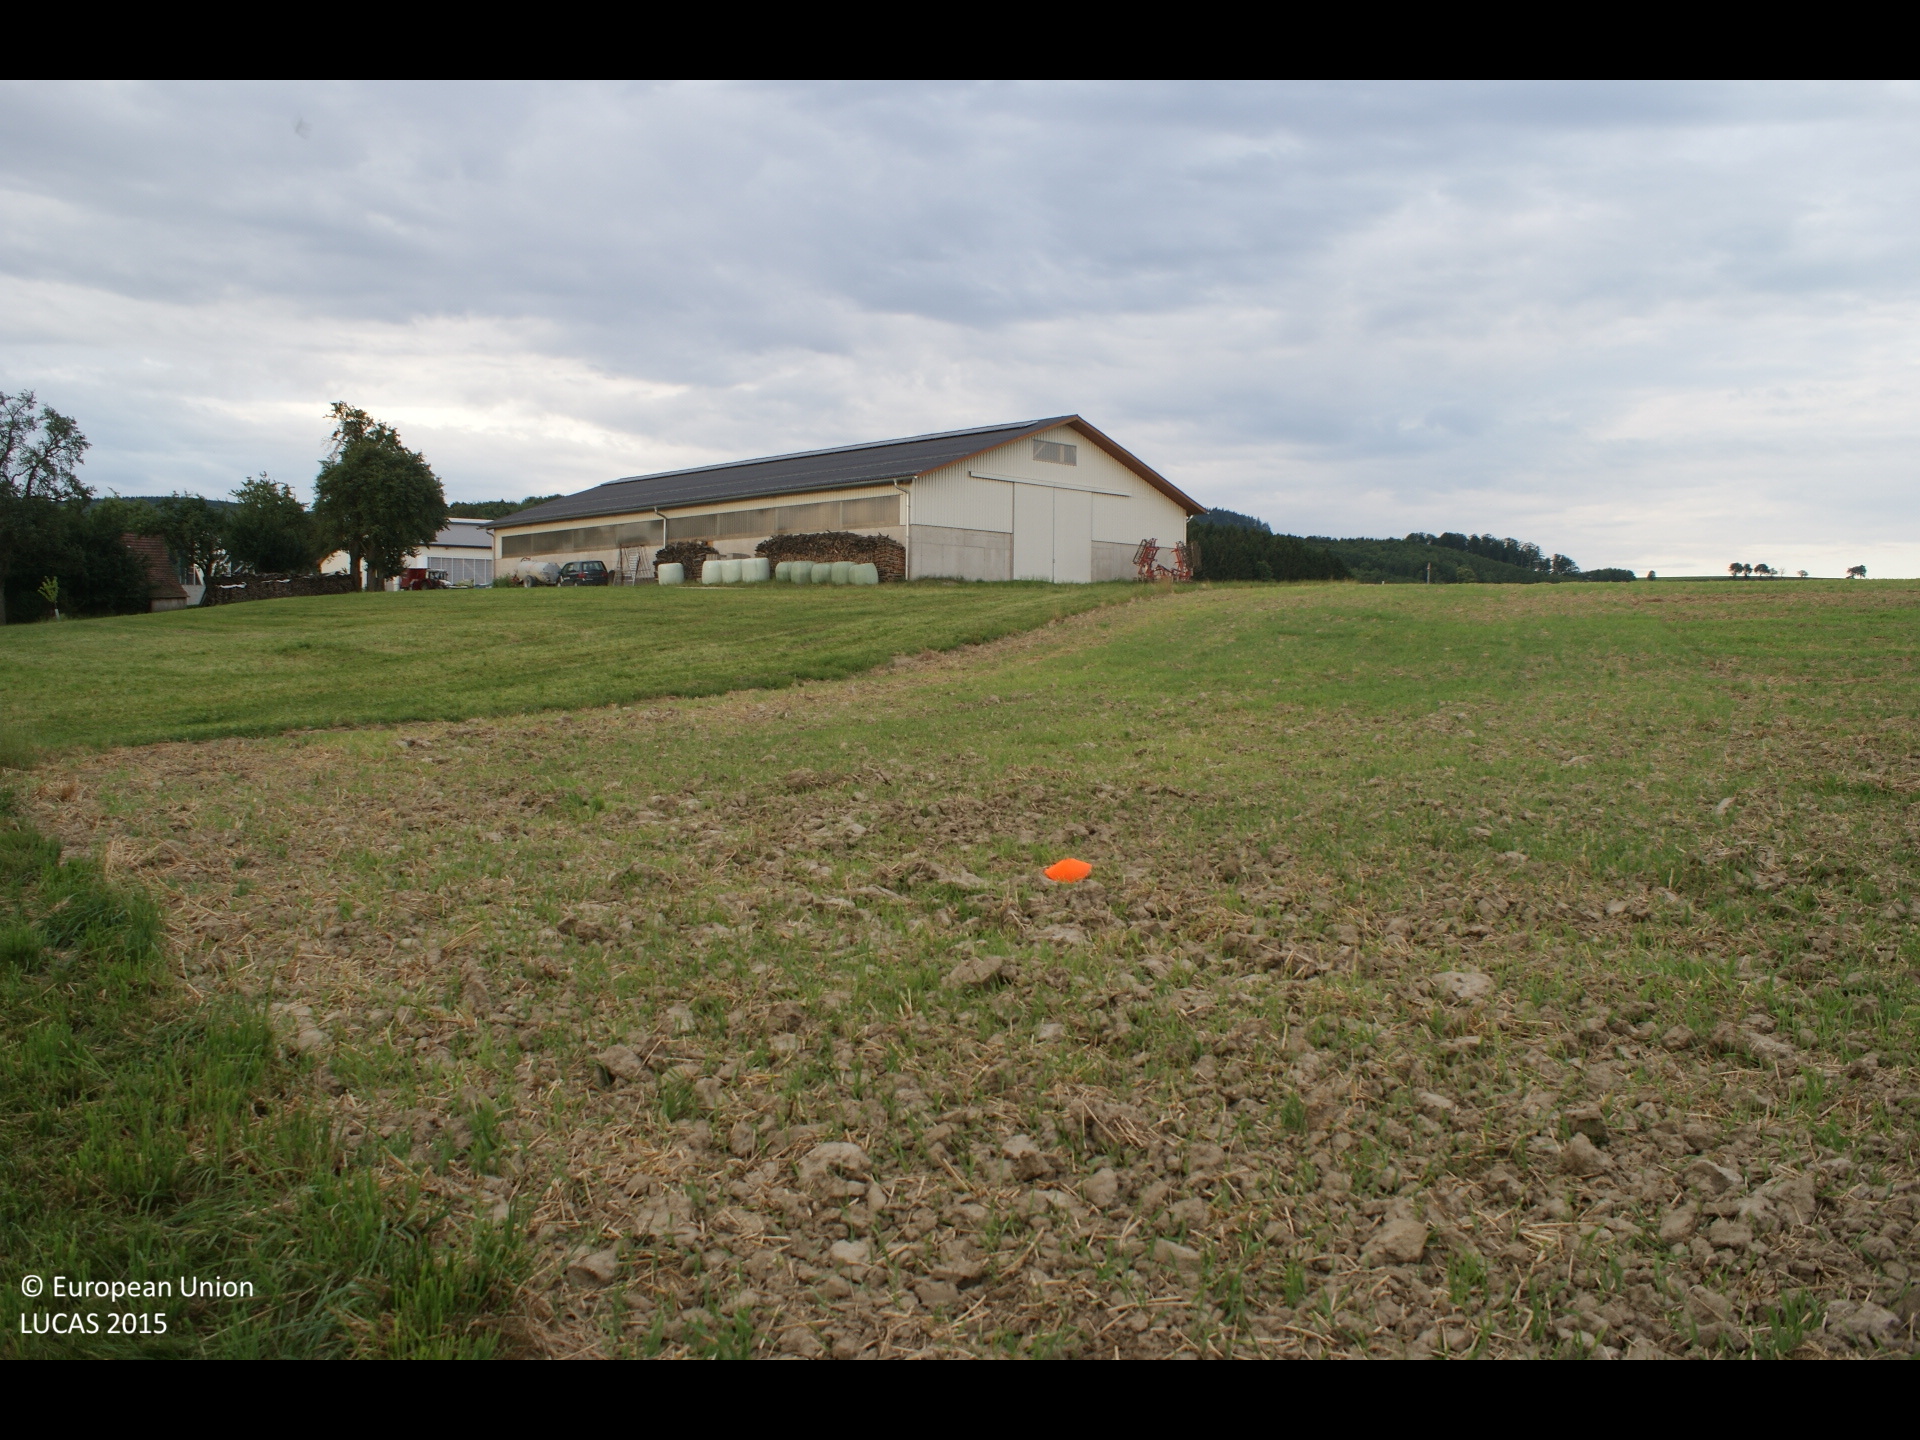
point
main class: Cropland
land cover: Temporary grasslands
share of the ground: 10 - 25 %
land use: Agriculture (excluding fallow land and kitchen gardens)
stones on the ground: < 10 %
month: July
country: AT
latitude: 48.0932
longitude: 15.3590
